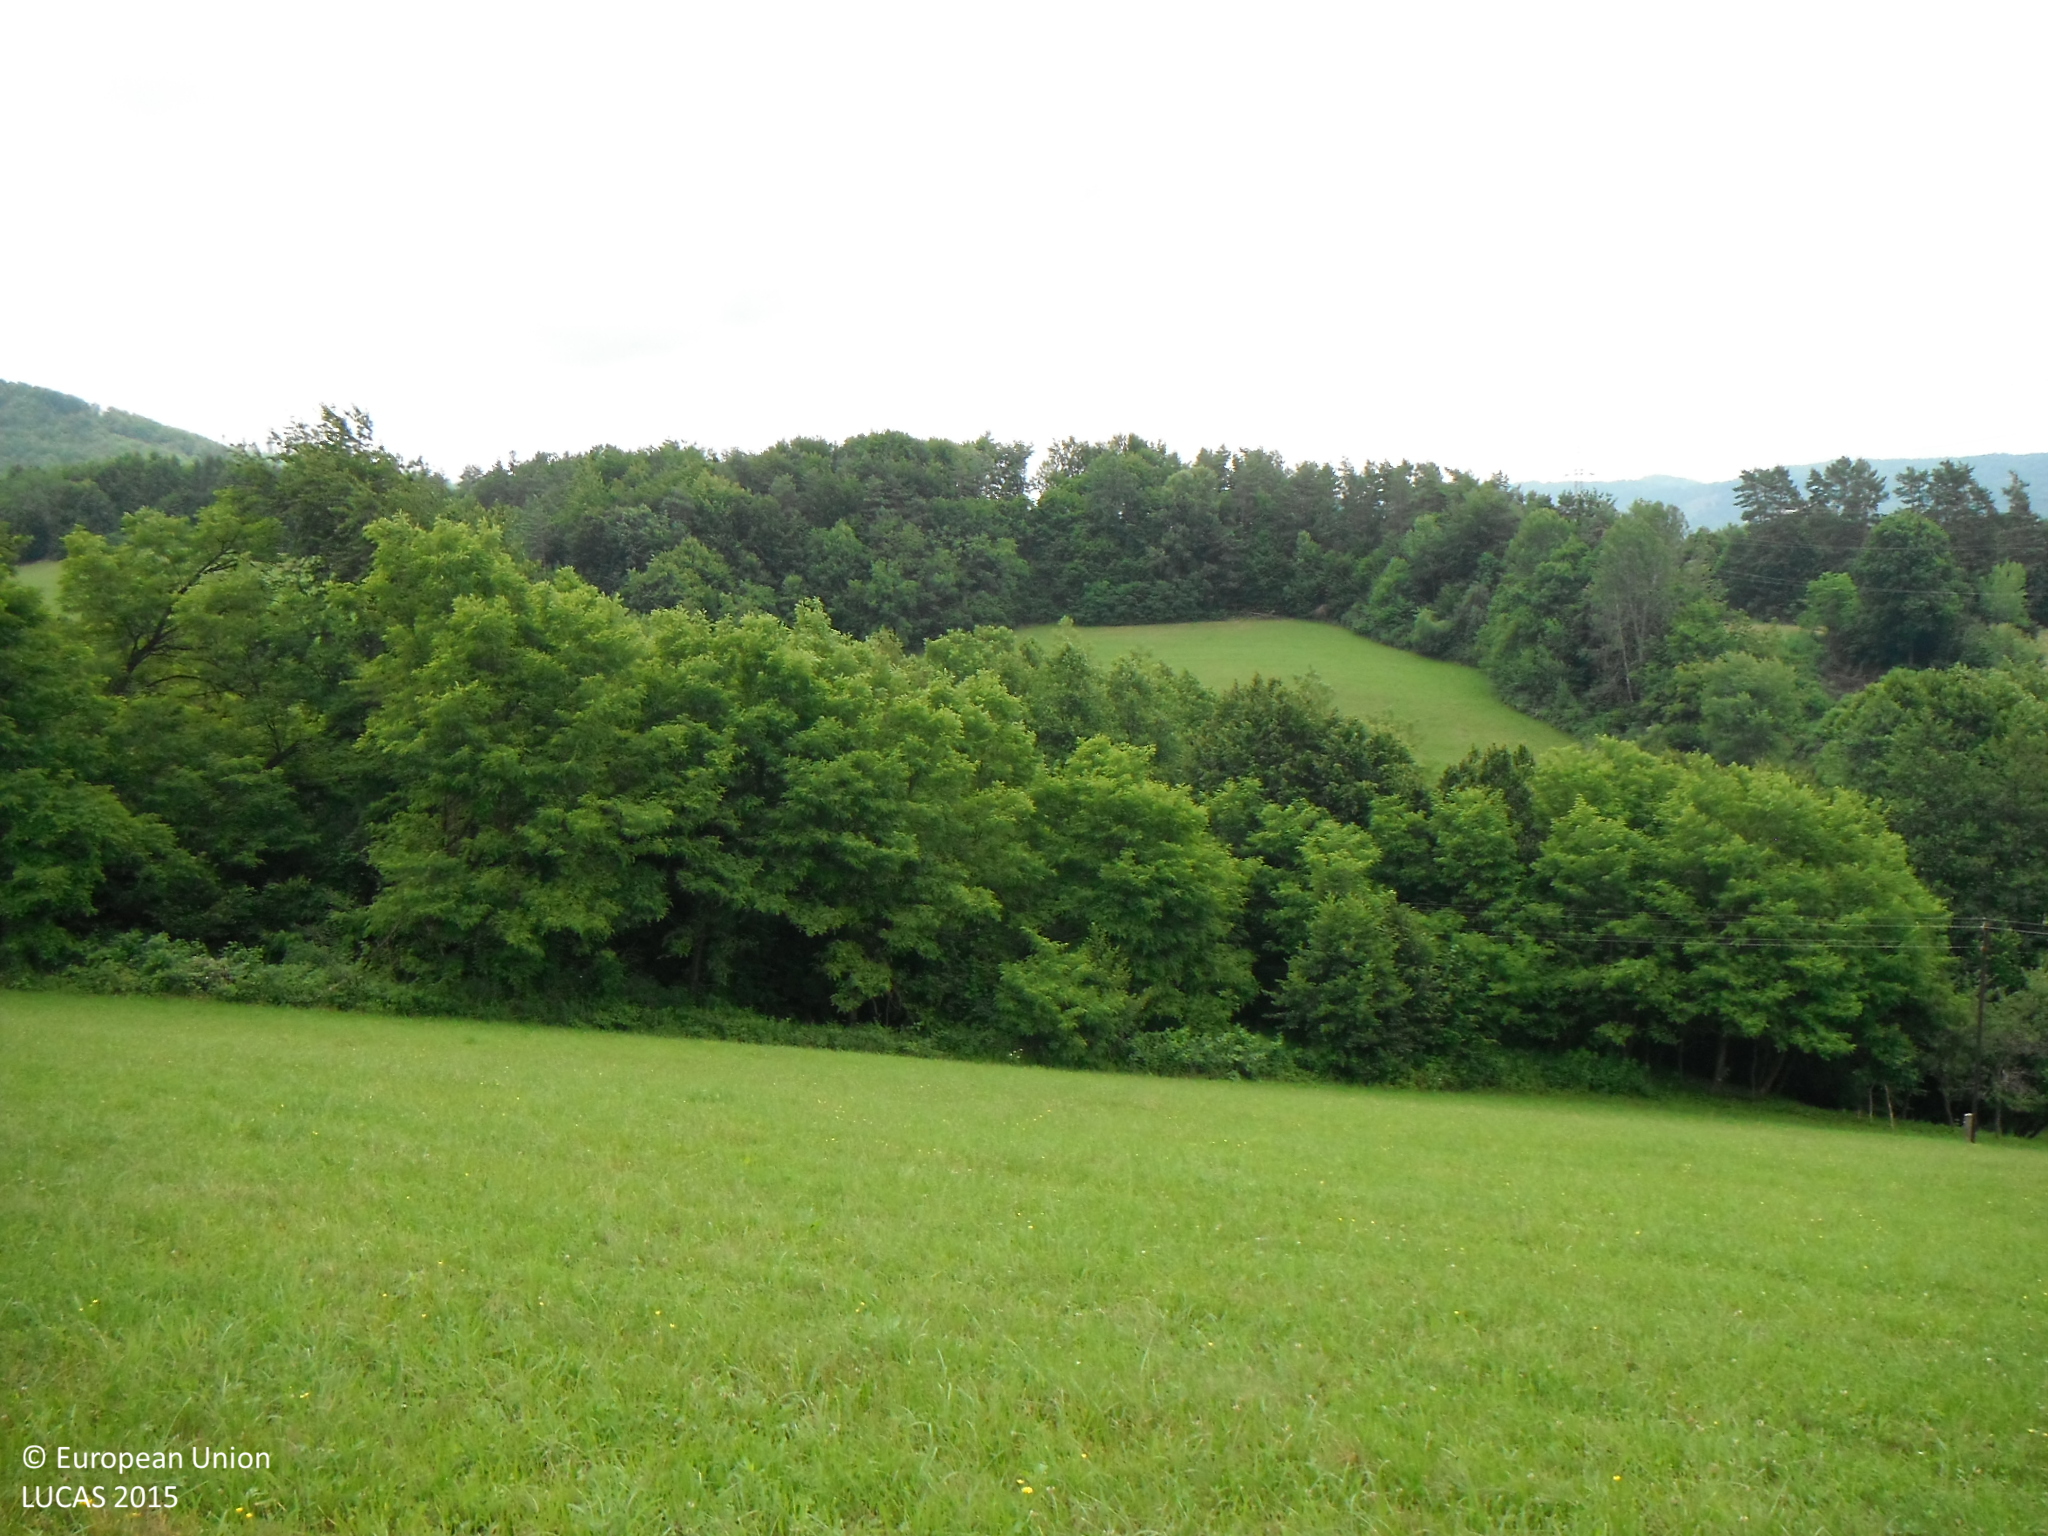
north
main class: Grassland
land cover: Grassland without tree/shrub cover
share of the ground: > 75 %
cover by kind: herbaceous plants 100 %
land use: Agriculture (excluding fallow land and kitchen gardens)
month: June
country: SK
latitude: 48.5890
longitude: 19.9397
